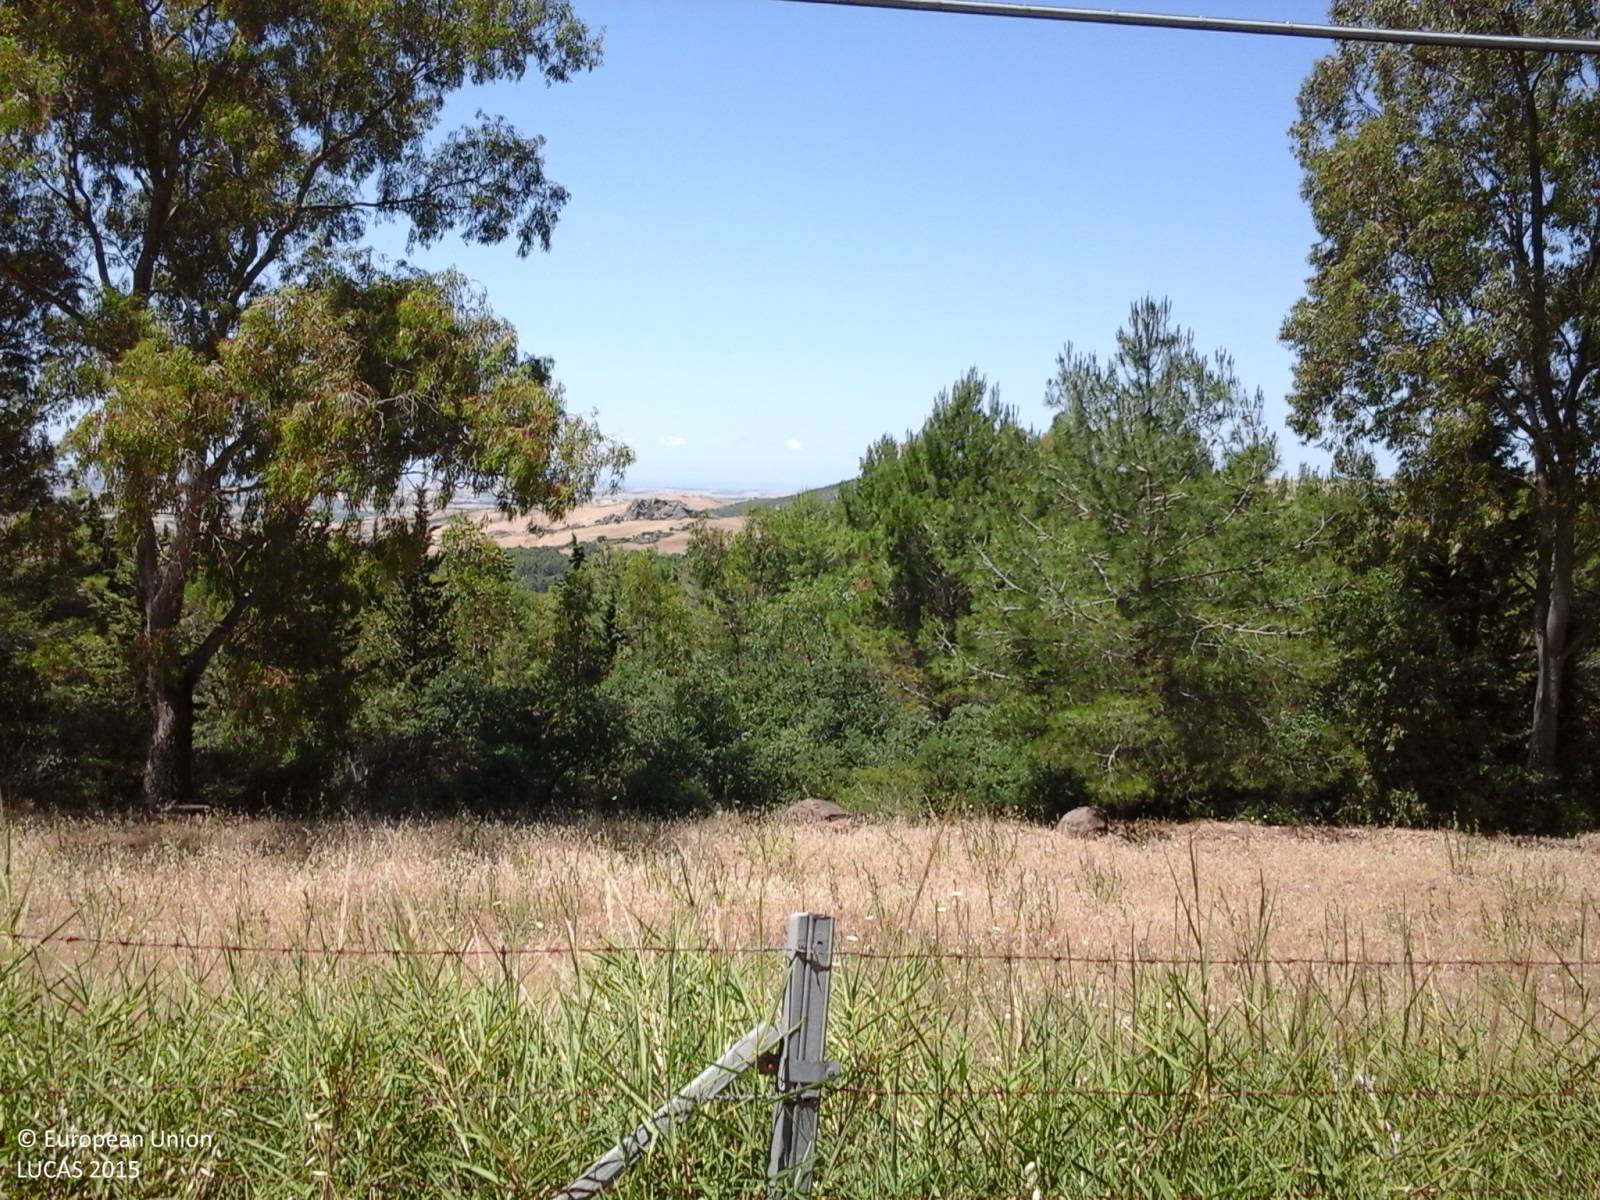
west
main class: Woodland
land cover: Other mixed woodland
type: coniferous forest of the mediterranean region
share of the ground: 50 - 75 %
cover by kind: coniferous forest trees 45 %, broadleaved forest trees 25 %, shrubs 15 %, herbaceous plants 15 %
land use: Forestry
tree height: > 5 m
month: June
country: IT
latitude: 37.9796
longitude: 12.7692
